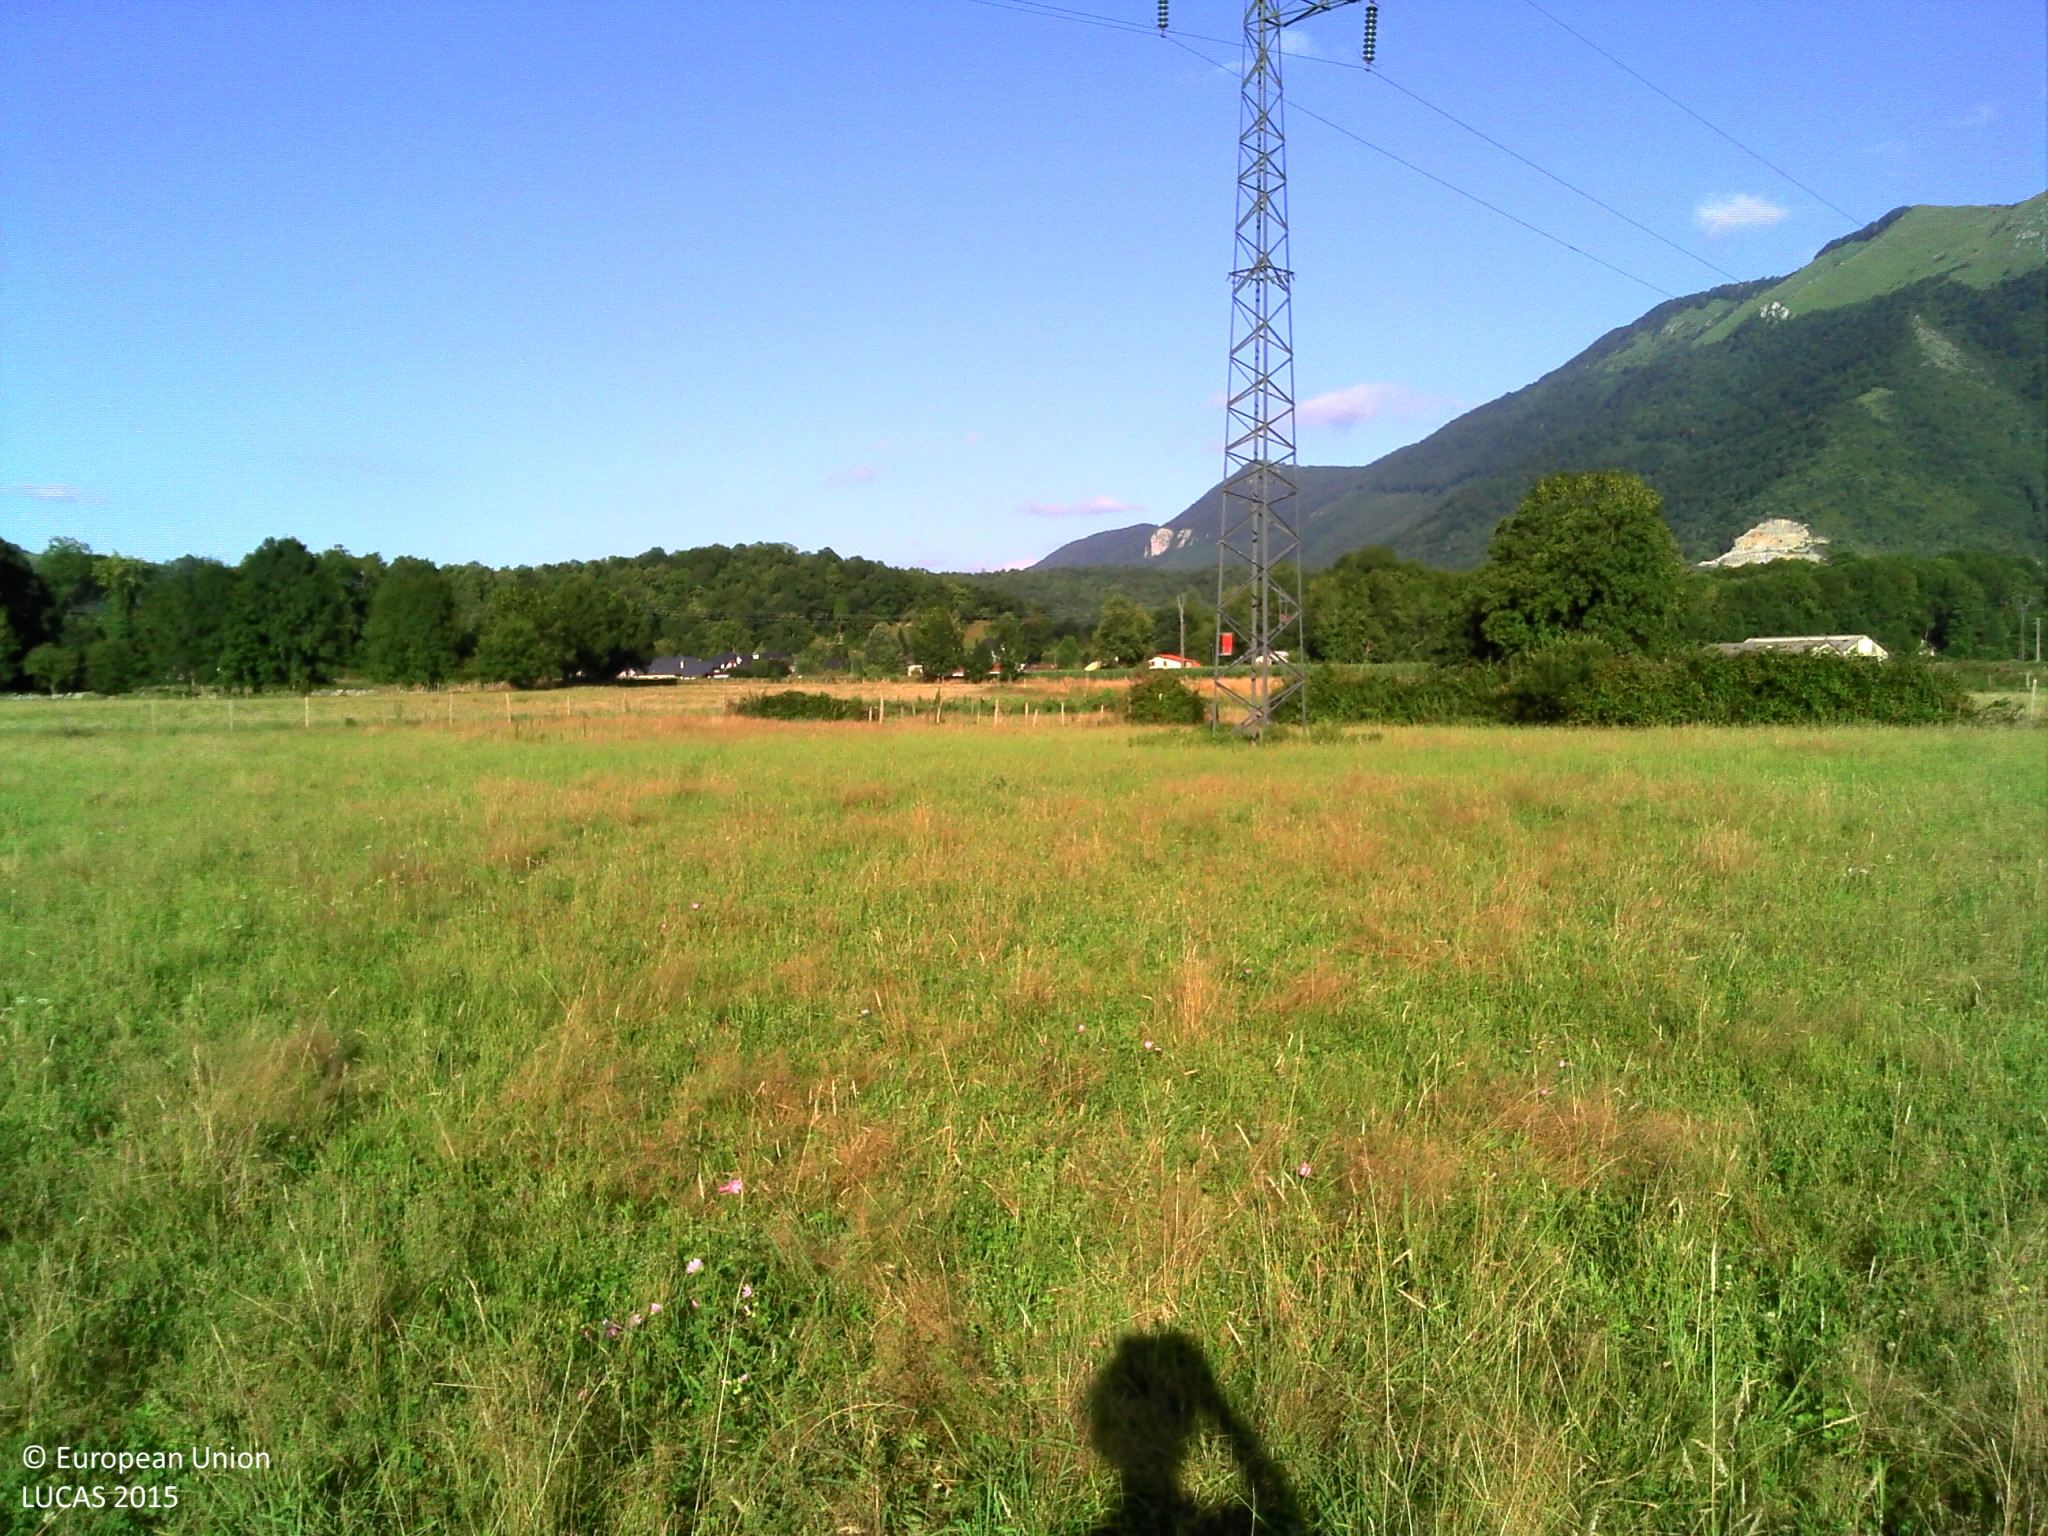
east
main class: Grassland
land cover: Grassland without tree/shrub cover
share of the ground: > 75 %
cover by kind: herbaceous plants 100 %
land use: Agriculture (excluding fallow land and kitchen gardens)
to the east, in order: Grassland without tree/shrub cover; Electric lines; Grassland without tree/shrub cover; Fences; Grassland without tree/shrub cover
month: July
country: FR
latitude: 43.0957
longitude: -0.4365
